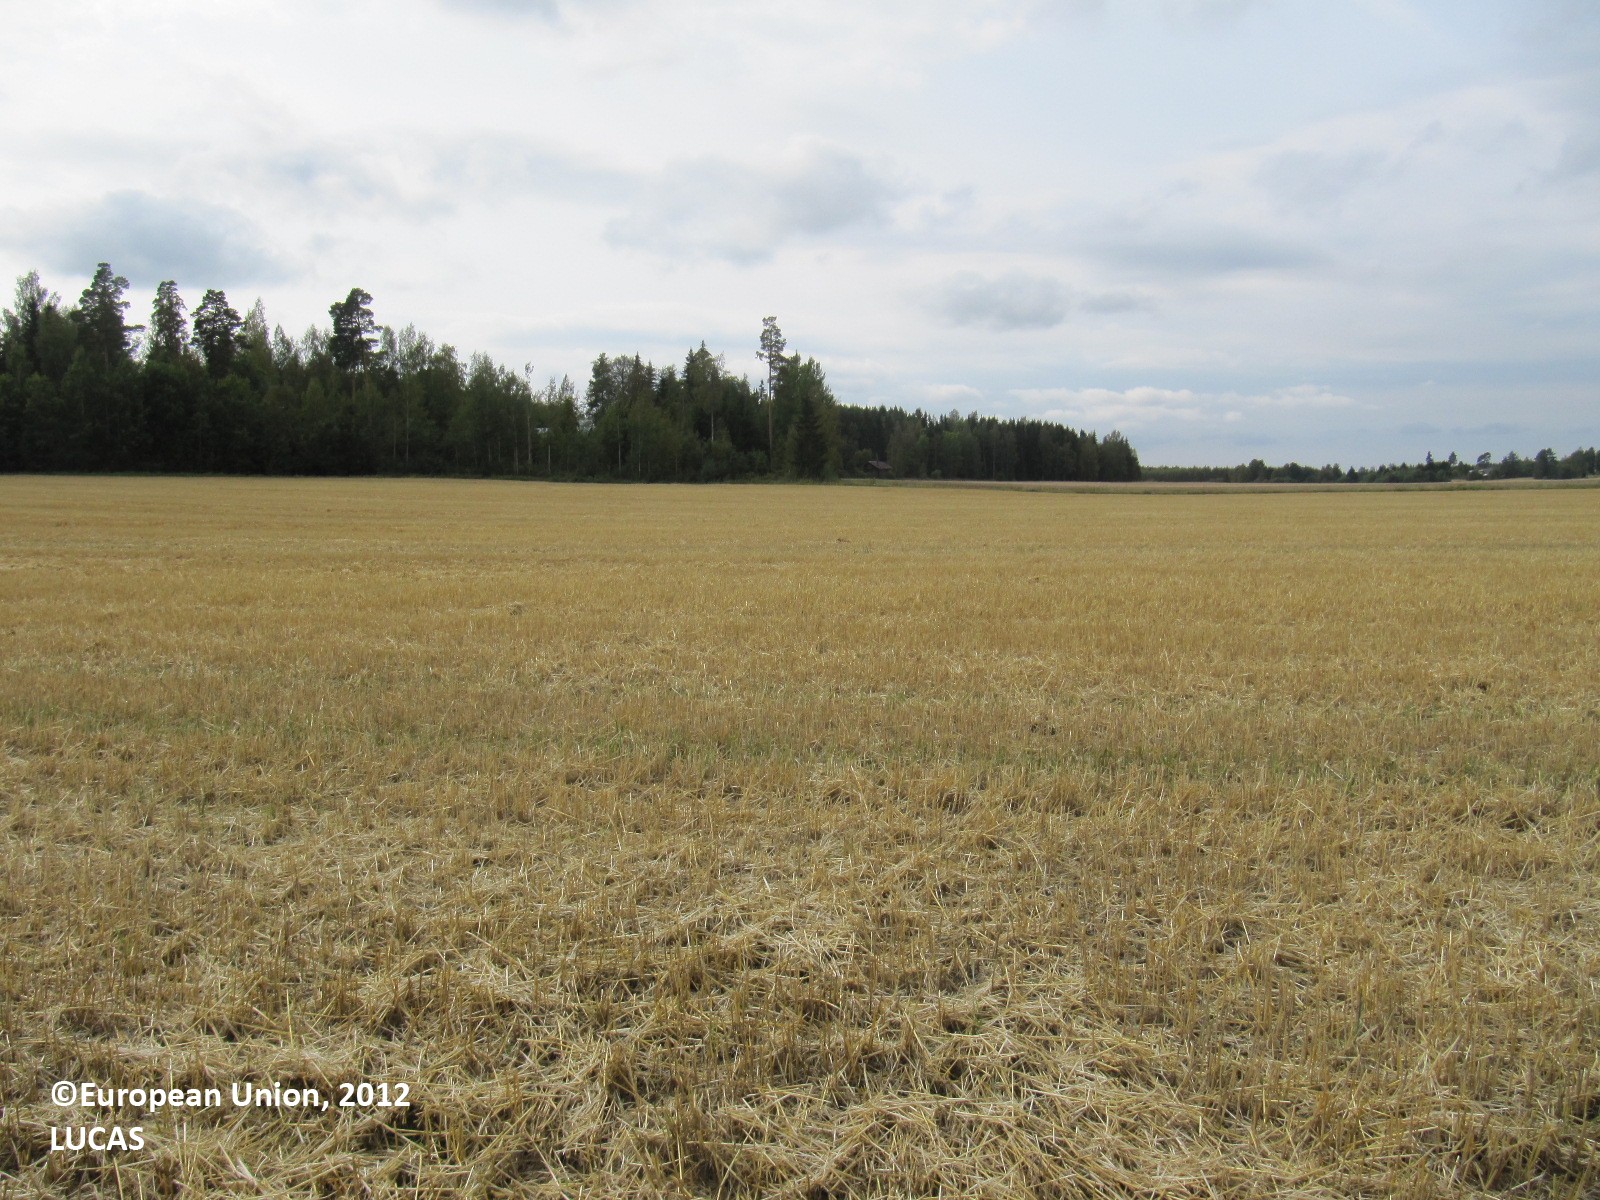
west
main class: Cropland
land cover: Barley
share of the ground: > 75 %
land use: Agriculture (excluding fallow land and kitchen gardens)
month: August
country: FI
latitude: 61.1389
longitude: 22.9054
